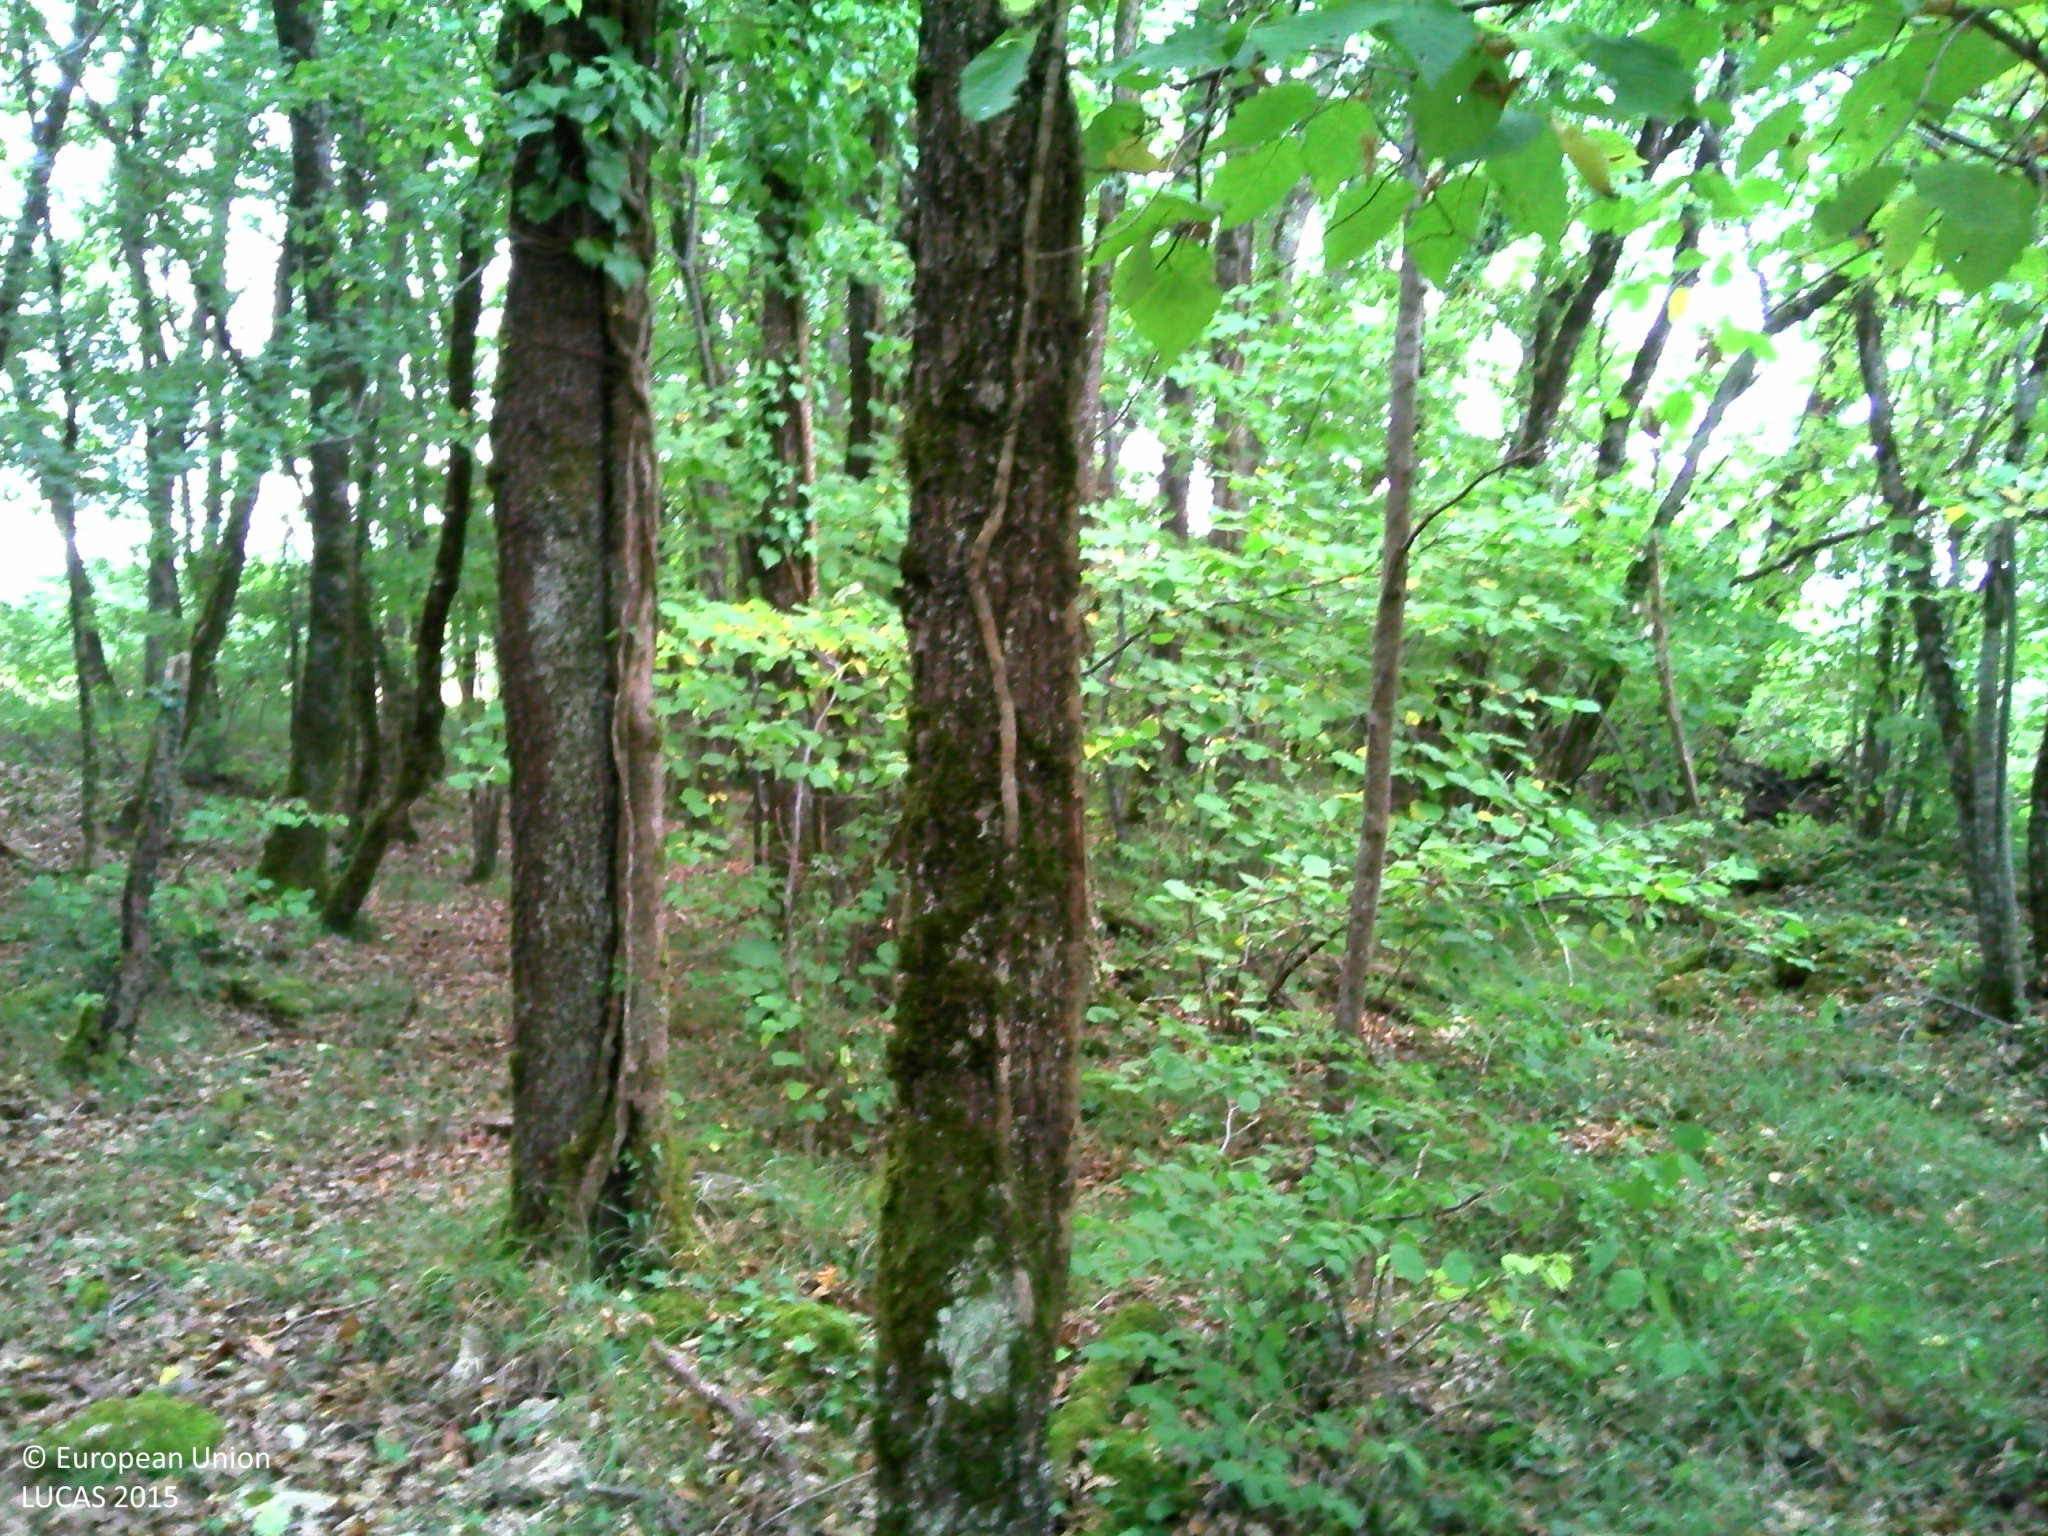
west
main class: Woodland
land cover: Broadleaved woodland
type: acidophilous oak and oak-birch forest
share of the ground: > 75 %
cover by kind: broadleaved forest trees 80 %, herbaceous plants 10 %, shrubs 5 %, lichens and mosses 5 %
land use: Forestry
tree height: > 5 m
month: July
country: FR
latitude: 44.9526
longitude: 0.7511
